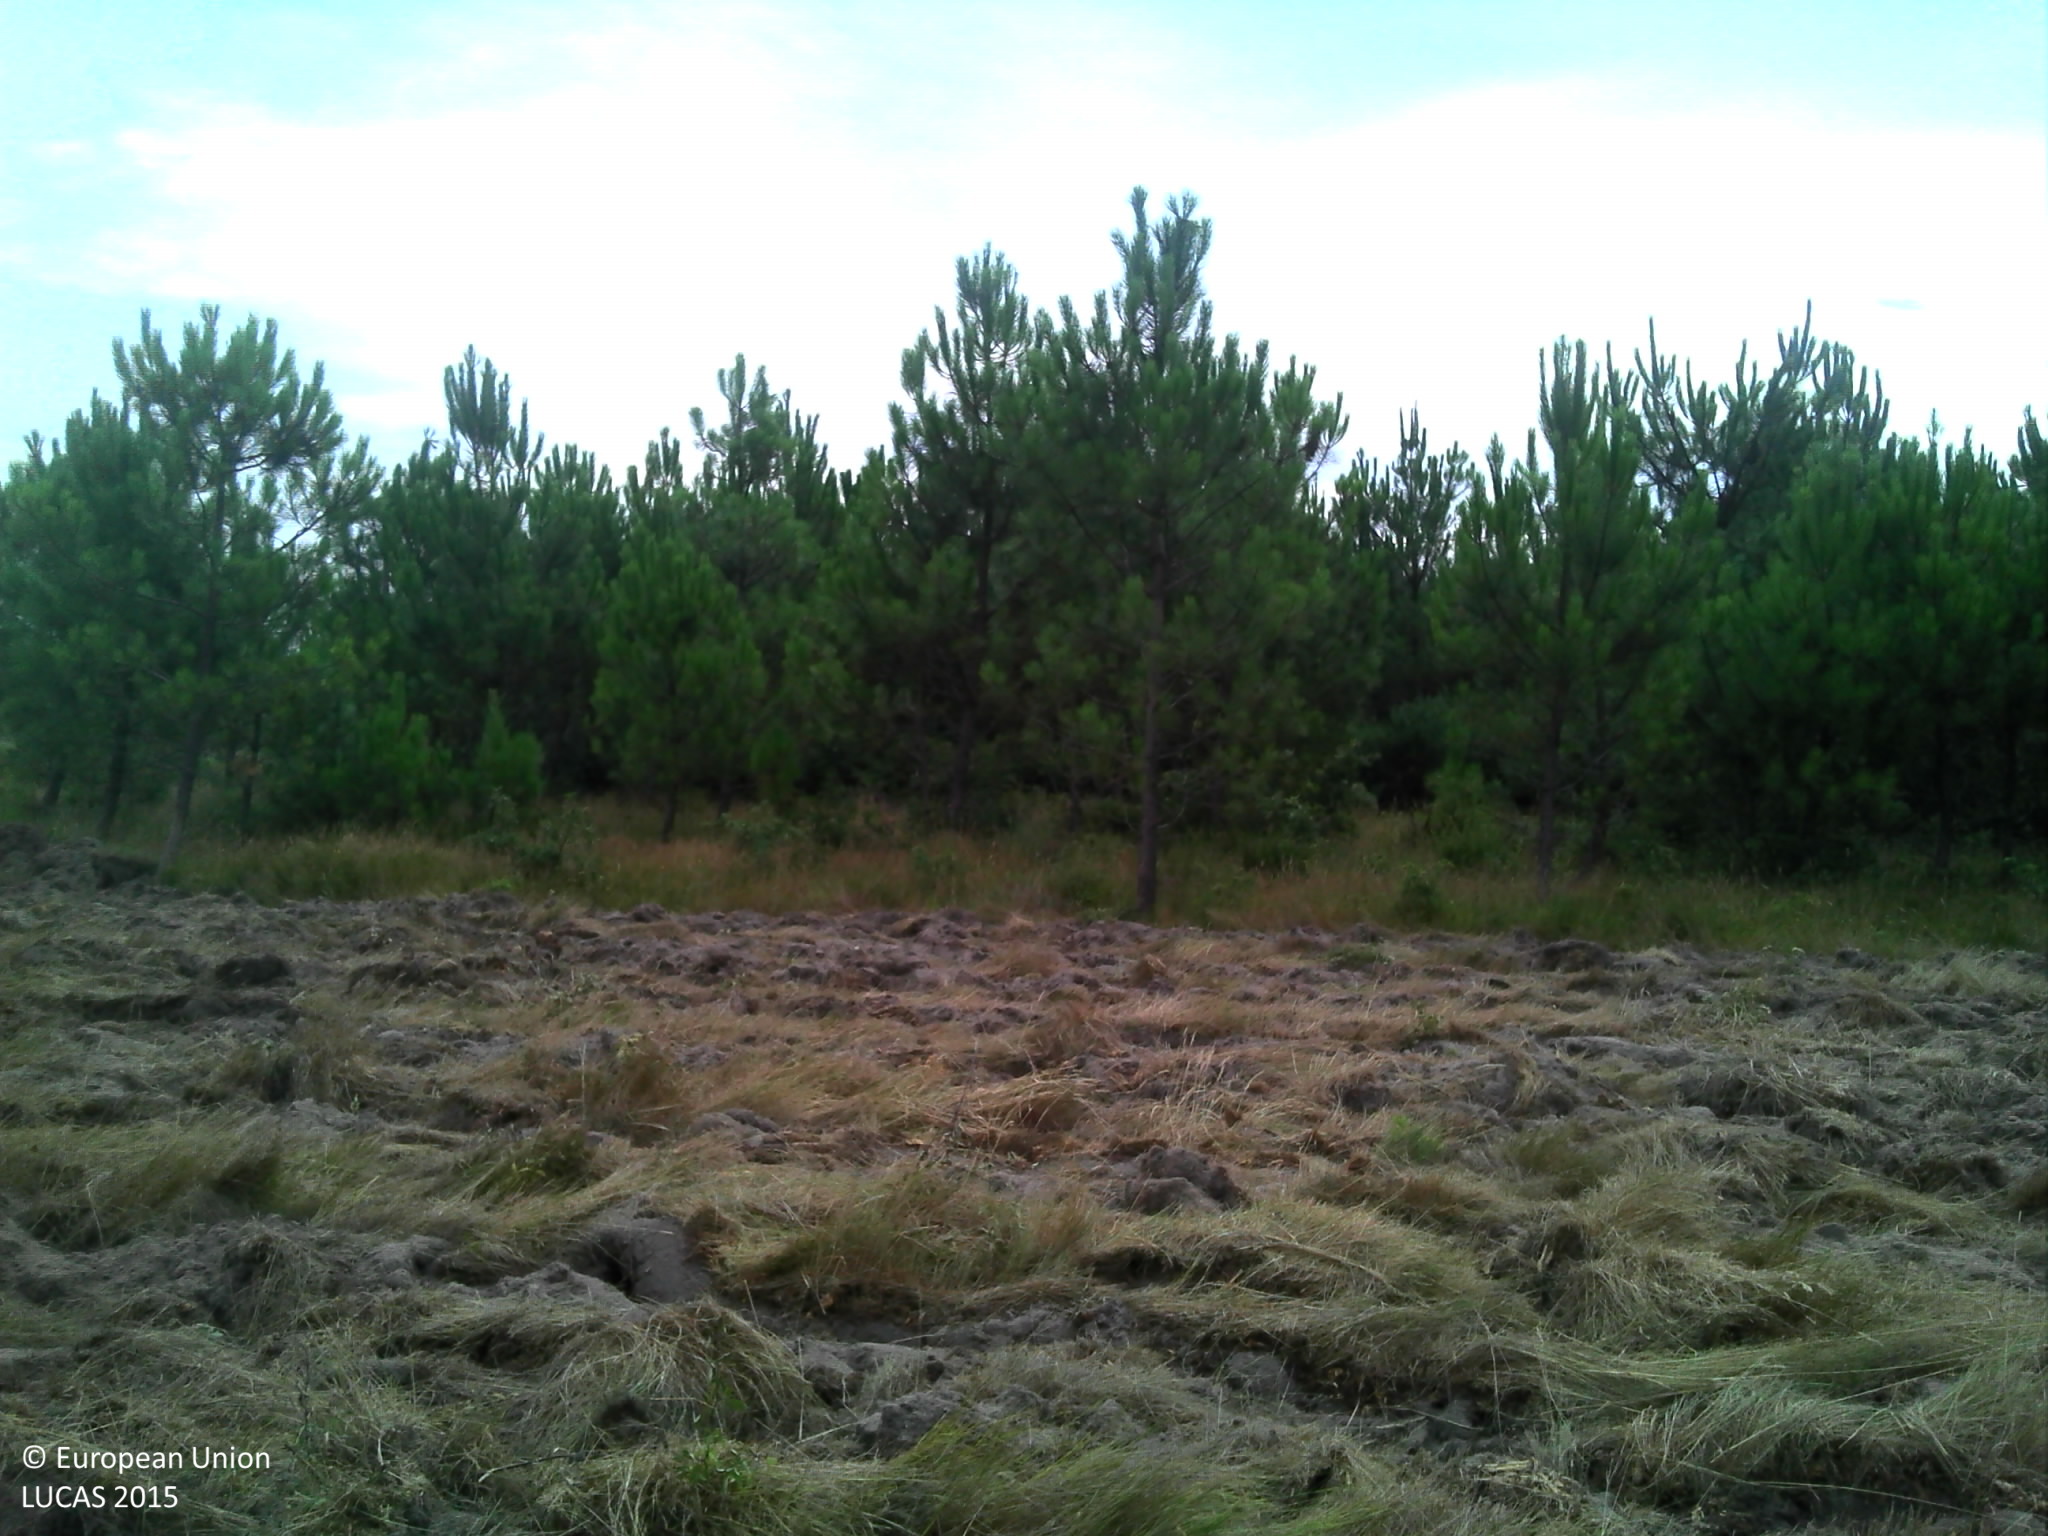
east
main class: Grassland
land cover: Spontaneously vegetated surfaces
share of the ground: 10 - 25 %
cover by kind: unconsolidated bare surface 80 %, herbaceous plants 20 %
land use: Forestry
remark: Tilled/Sowed
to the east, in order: Spontaneously vegetated surfaces; Pine dominated coniferous woodland; Tracks; Electric lines; Pine dominated coniferous woodland; Spontaneously vegetated surfaces; Tracks; Spontaneously vegetated surfaces; Ditches and canals; Single bushes/trees; Spontaneously vegetated surfaces
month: July
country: FR
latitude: 44.0848
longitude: -0.5415
